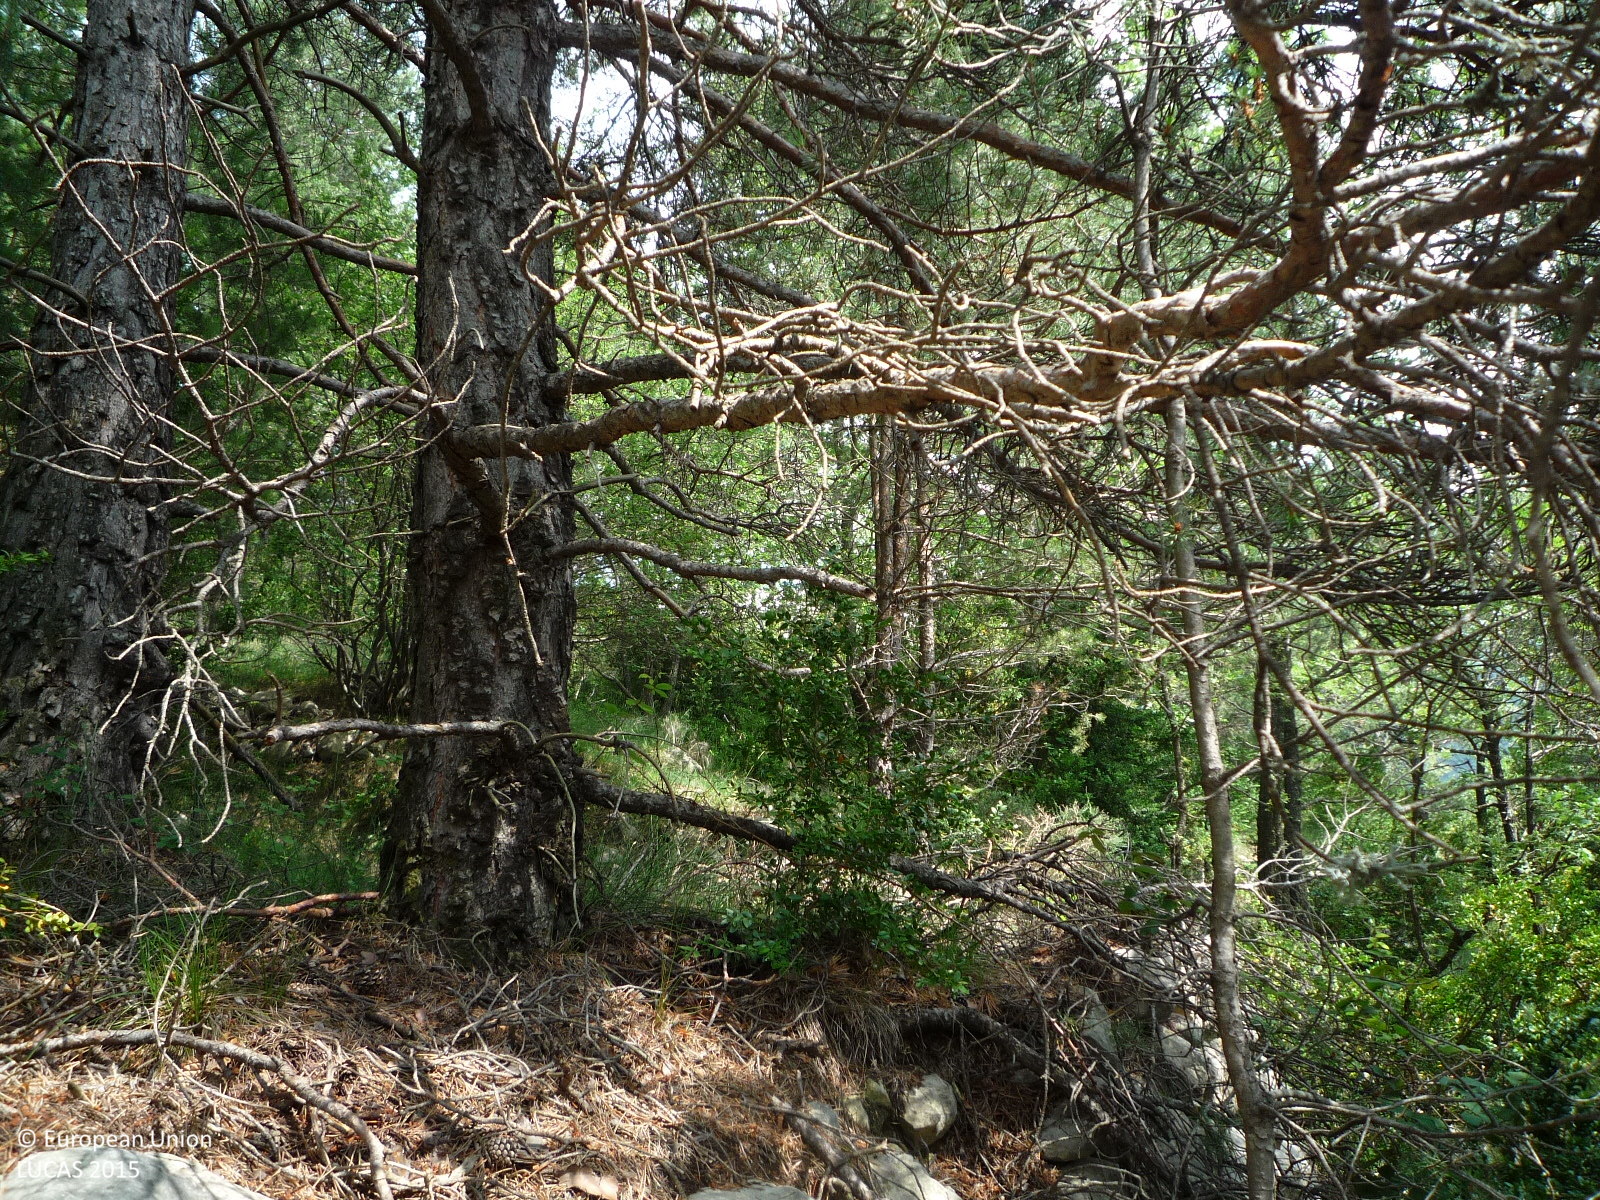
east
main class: Woodland
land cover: Pine dominated coniferous woodland
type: alpine coniferous forest
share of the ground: > 75 %
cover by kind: coniferous forest trees 80 %, herbaceous plants 20 %
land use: Semi-natural and natural areas not in use
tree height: > 5 m
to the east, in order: Dry stone walls; Pine dominated coniferous woodland; Rock outcrops; Pine dominated mixed woodland; Rock outcrops; Shrubland with sparse tree cover; Rock outcrops; Pine dominated mixed woodland; Rocks and stones; Shrubland with sparse tree cover; Rocks and stones; Shrubland with sparse tree cover; Pine dominated coniferous woodland; Dry stone walls; Pine dominated coniferous woodland; Dry stone walls; Pine dominated coniferous woodland; Rock outcrops; Pine dominated coniferous woodland; Rivers and streams; Pine dominated coniferous woodland
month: June
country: ES
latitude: 42.2210
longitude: 1.9075
